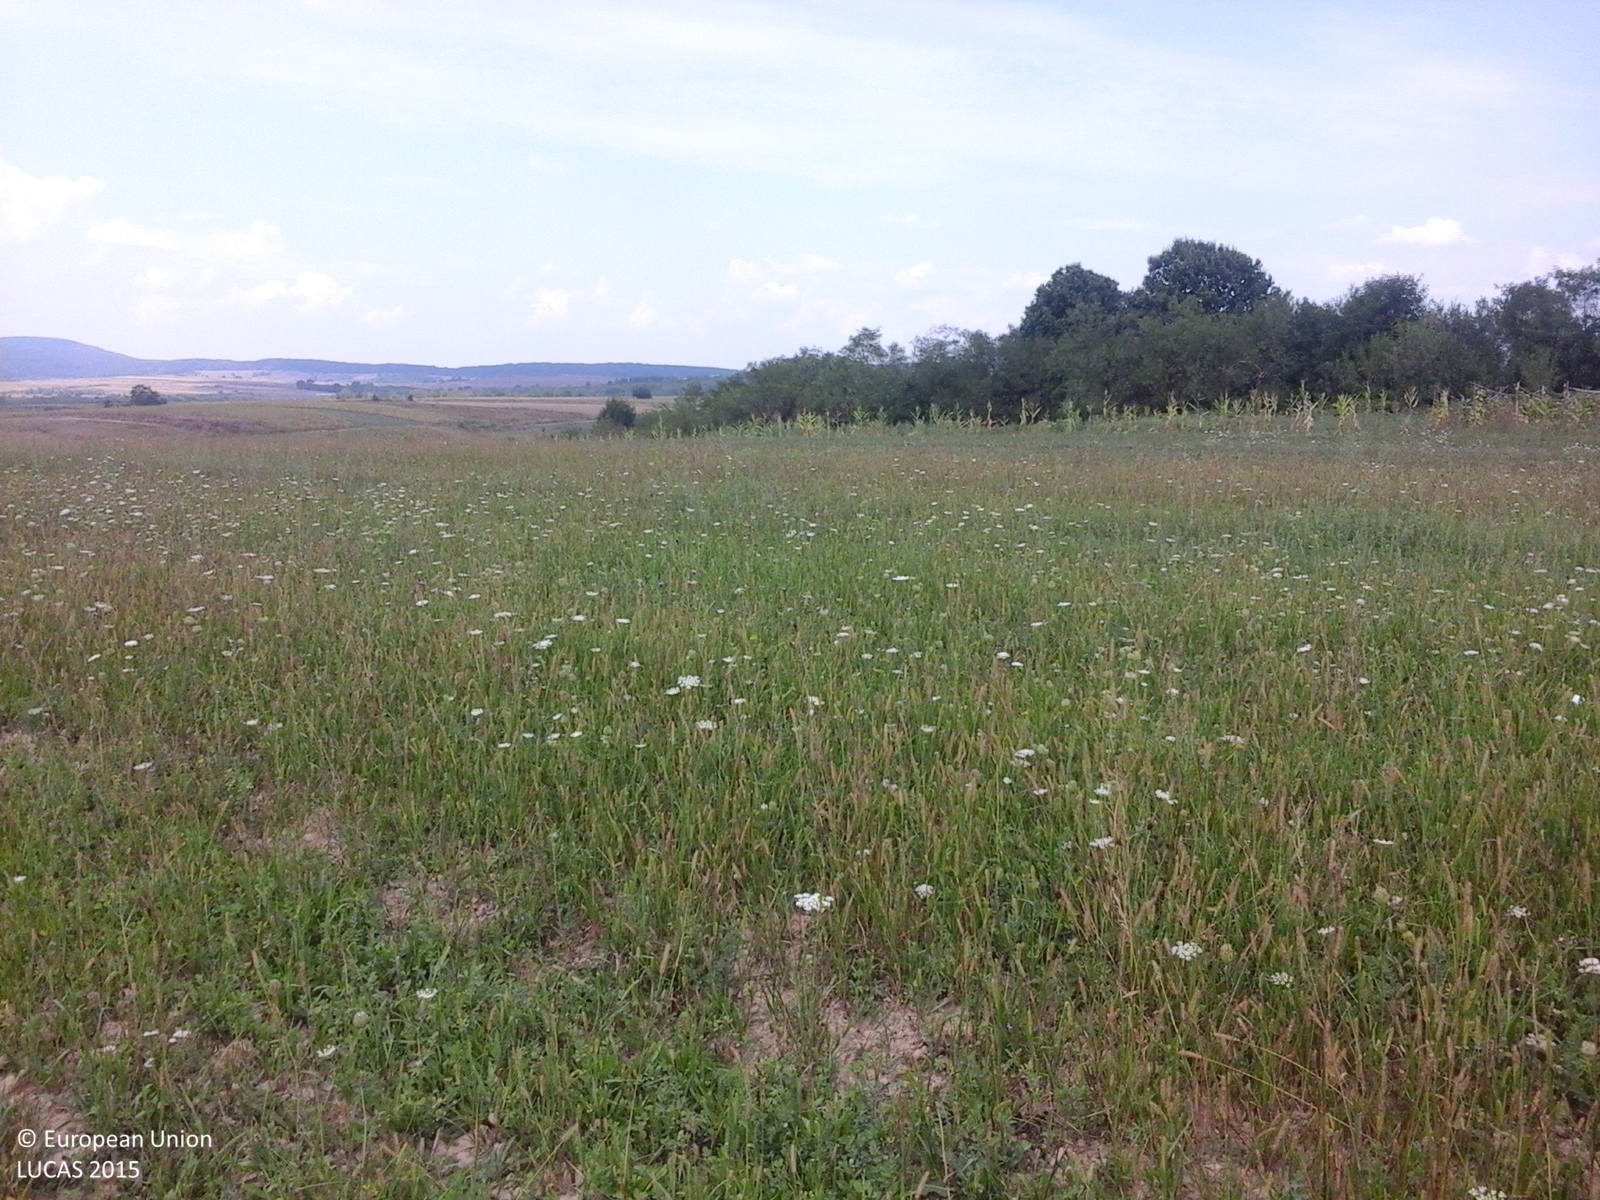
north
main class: Grassland
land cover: Grassland without tree/shrub cover
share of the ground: > 75 %
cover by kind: herbaceous plants 100 %
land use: Agriculture (excluding fallow land and kitchen gardens)
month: August
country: RO
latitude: 46.3188
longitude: 22.2416
